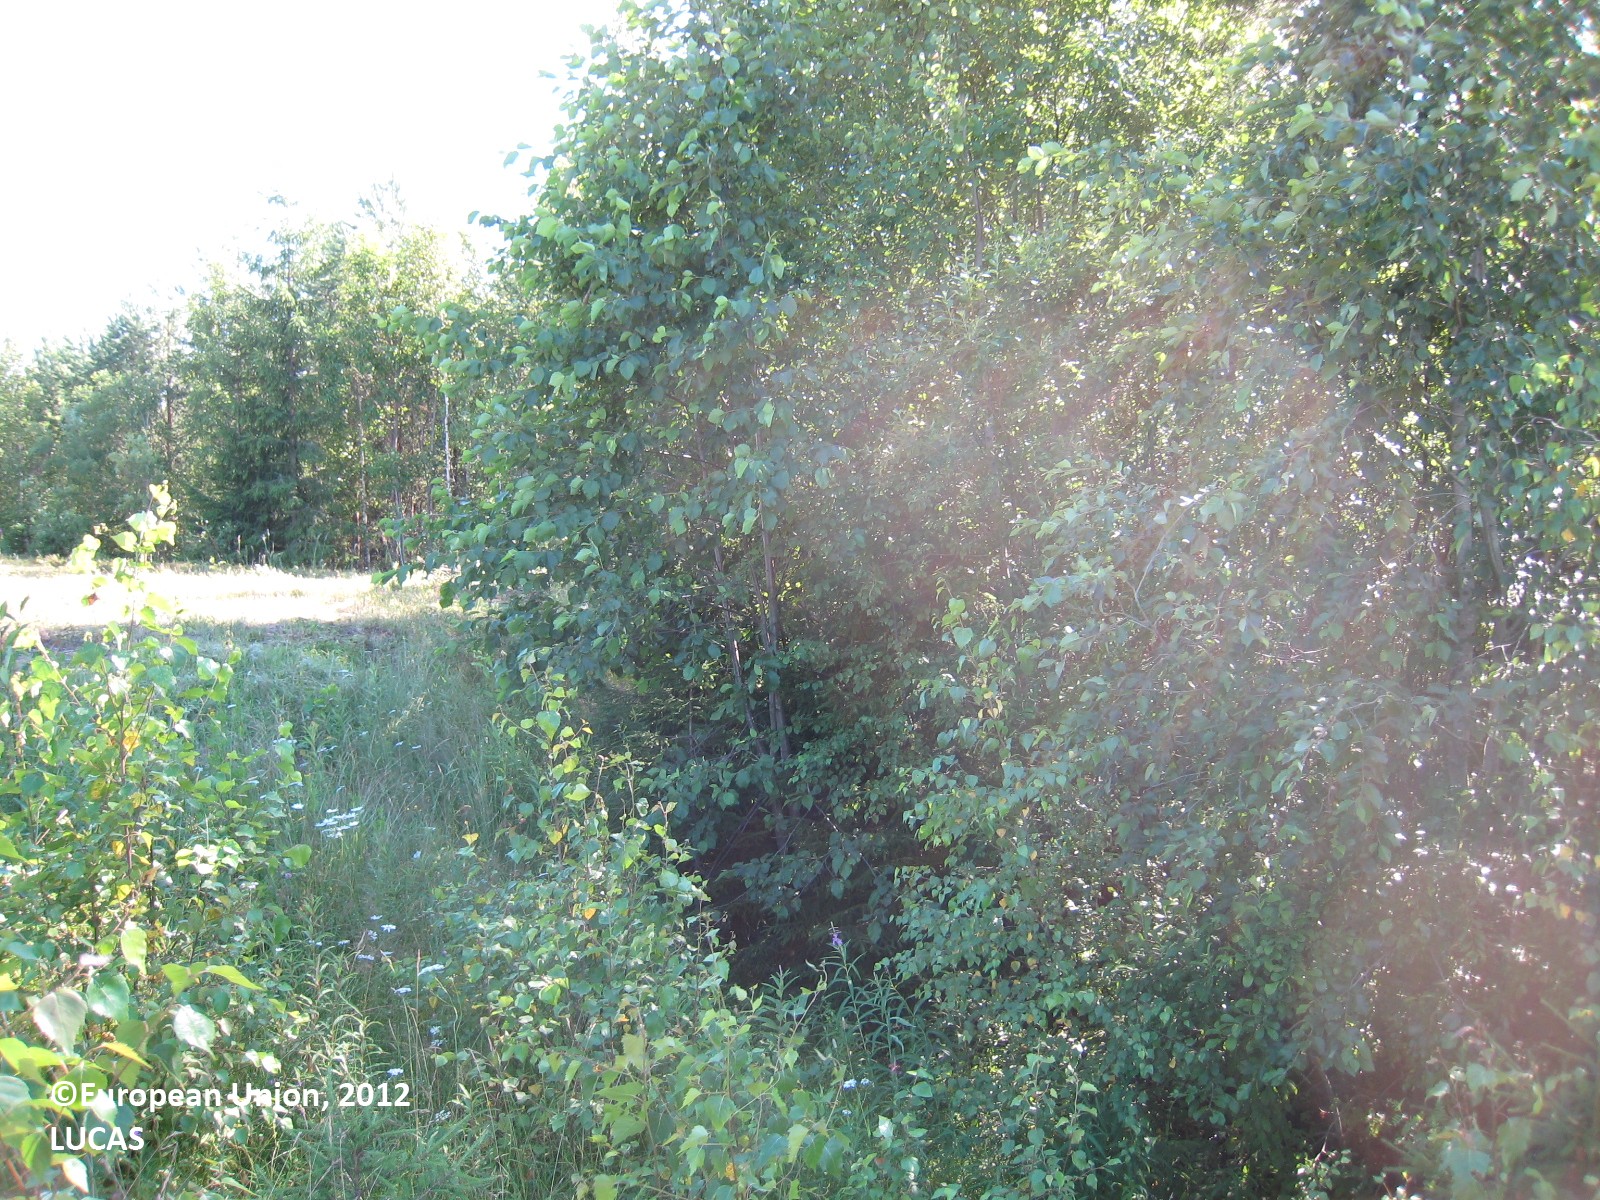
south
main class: Grassland
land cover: Grassland with sparse tree/shrub cover
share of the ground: > 75 %
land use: Road transport
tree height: < 5 m
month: July
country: FI
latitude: 62.9545
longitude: 26.7986
